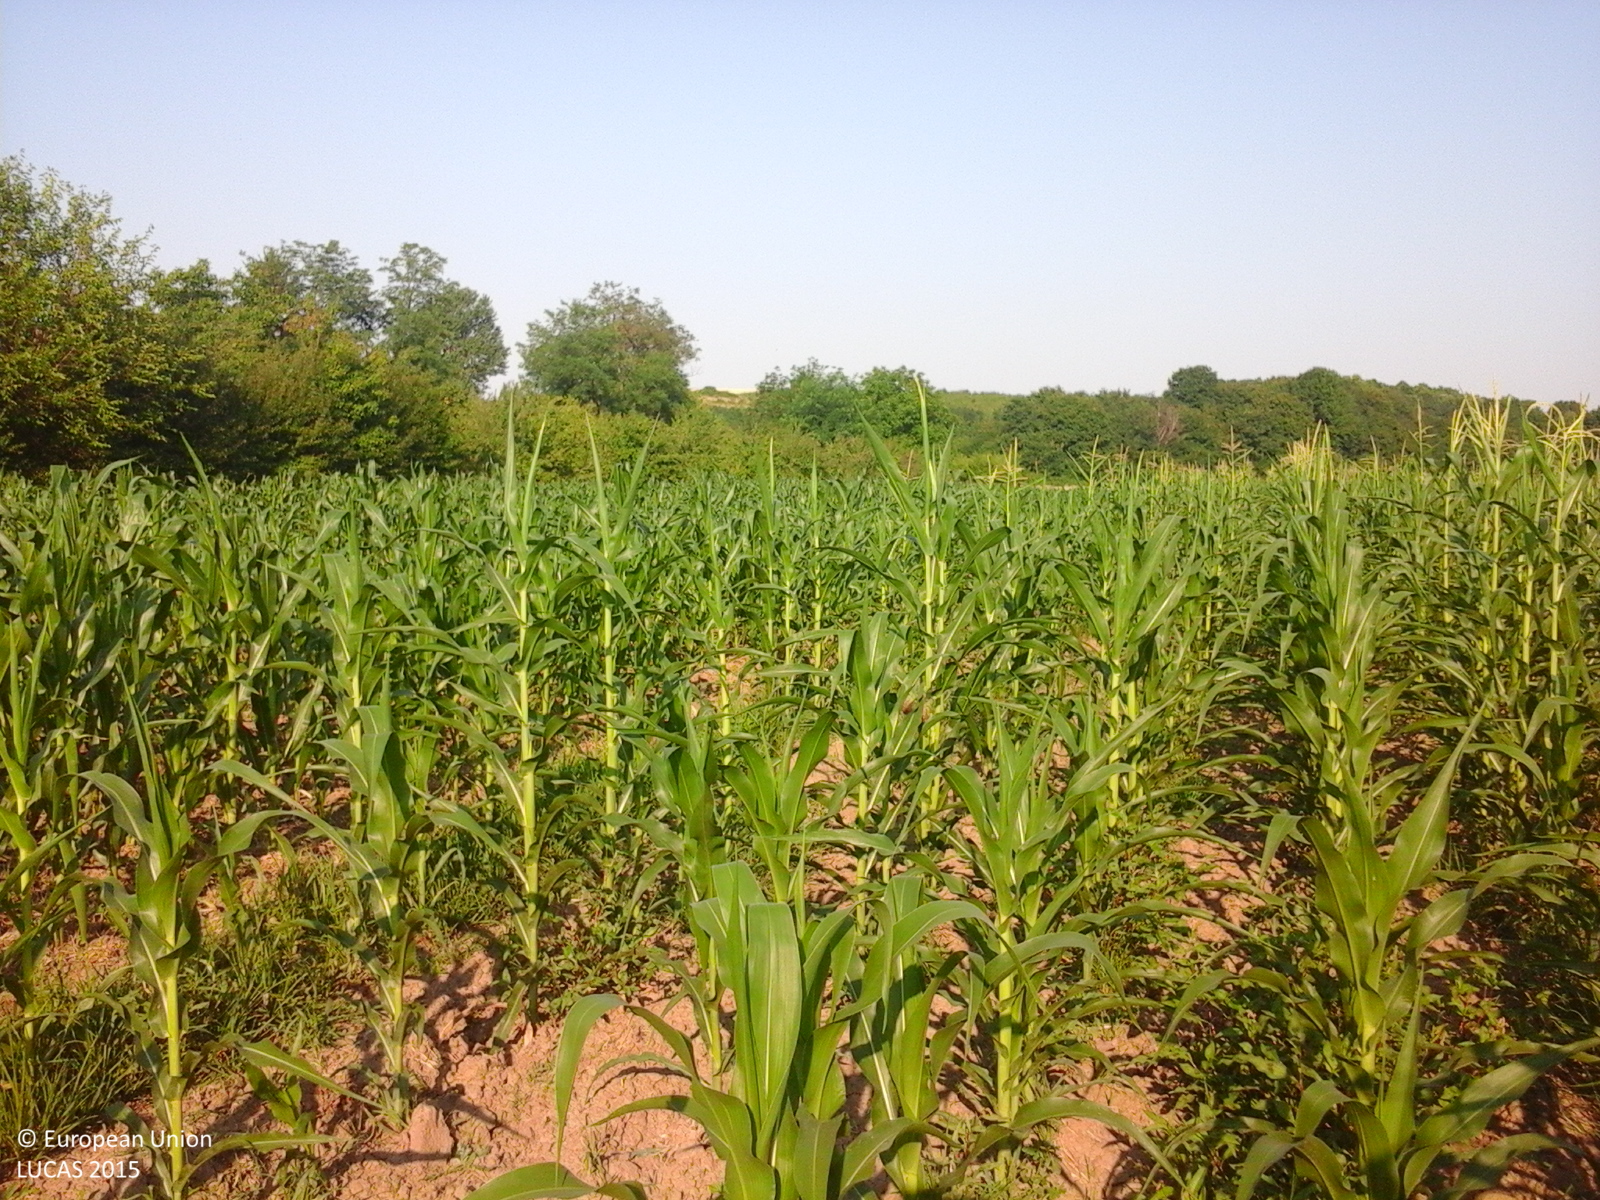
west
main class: Cropland
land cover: Maize
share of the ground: > 75 %
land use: Agriculture (excluding fallow land and kitchen gardens)
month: July
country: RO
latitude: 44.6070
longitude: 24.7561
